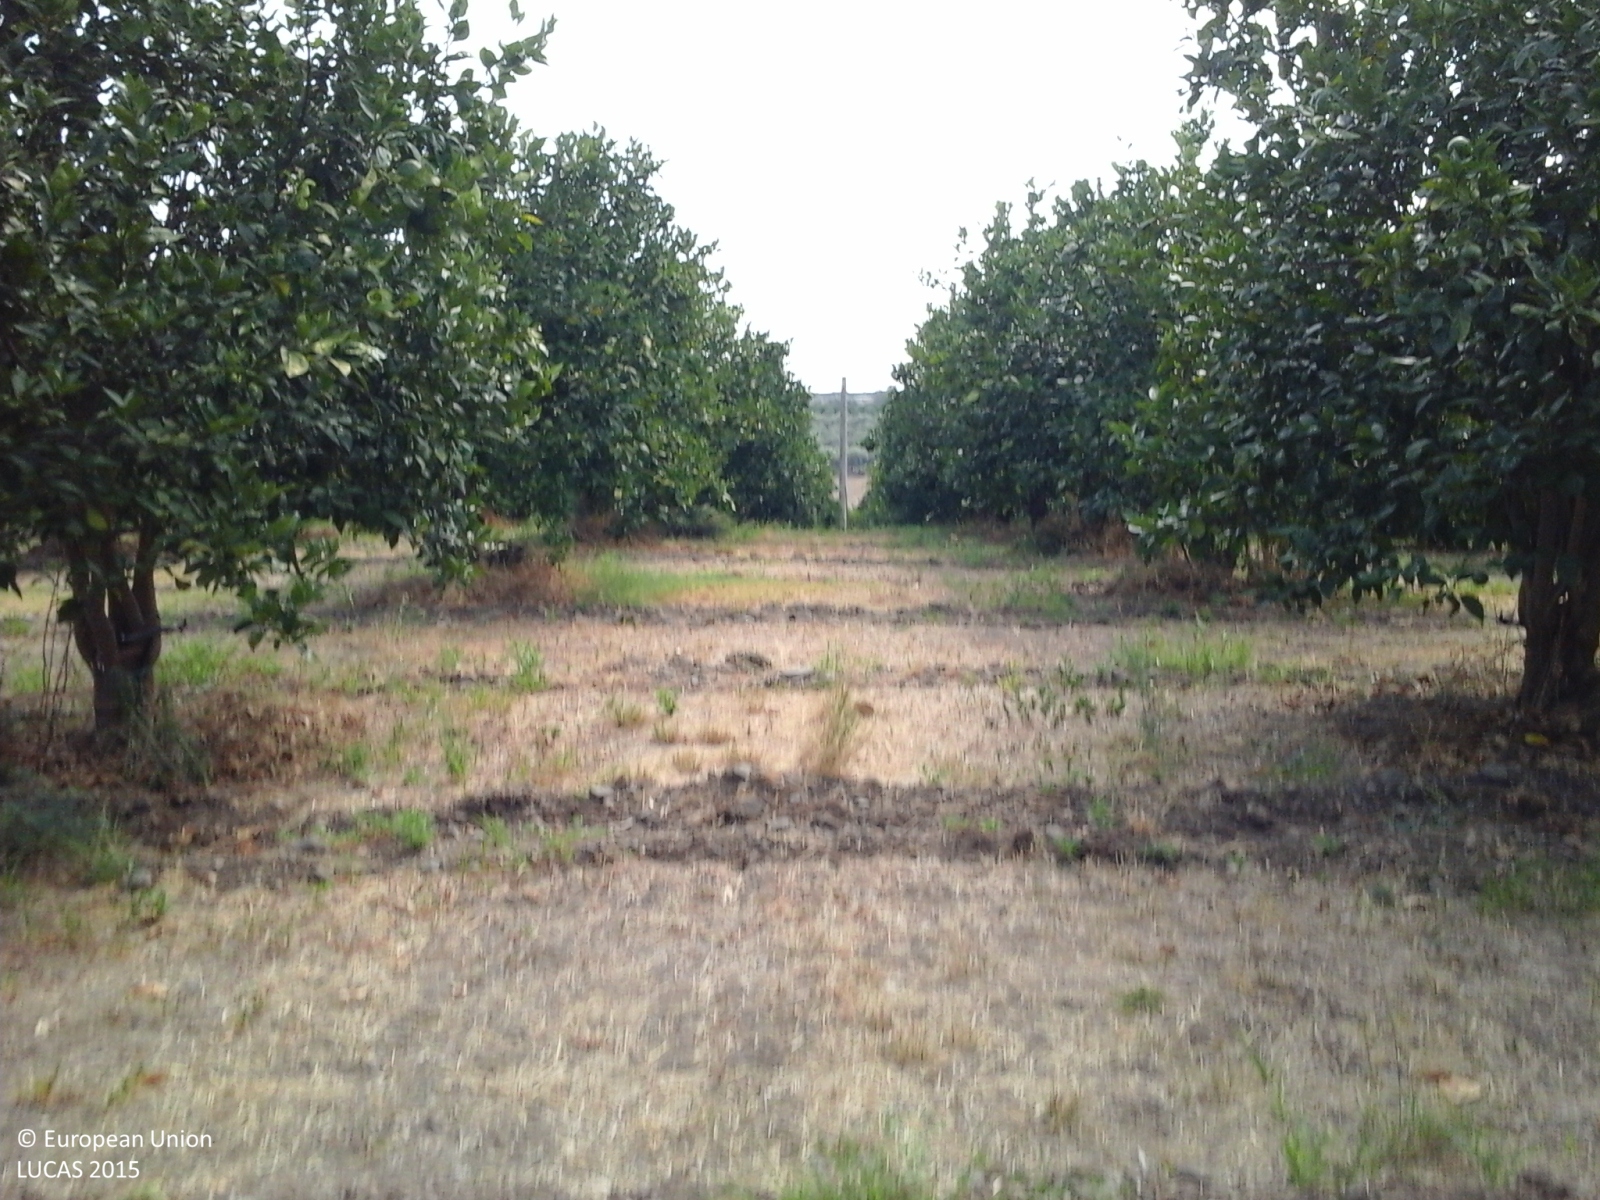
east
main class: Cropland
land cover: Oranges
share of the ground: > 75 %
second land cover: Spontaneously vegetated surfaces
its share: > 75 %
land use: Agriculture (excluding fallow land and kitchen gardens)
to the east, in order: Oranges; Spontaneously vegetated surfaces; Grass margins; Tracks; Grass margins; Electric lines; Ditches and canals; Grass margins; Oranges; Electric lines; Oranges; Grass margins; Fences; Other bare soil; Fences; Olive groves; Electric lines; Olive groves; Grass margins; Fences; Ditches and canals; Grass margins; Tracks
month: August
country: IT
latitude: 37.2953
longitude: 14.8708
